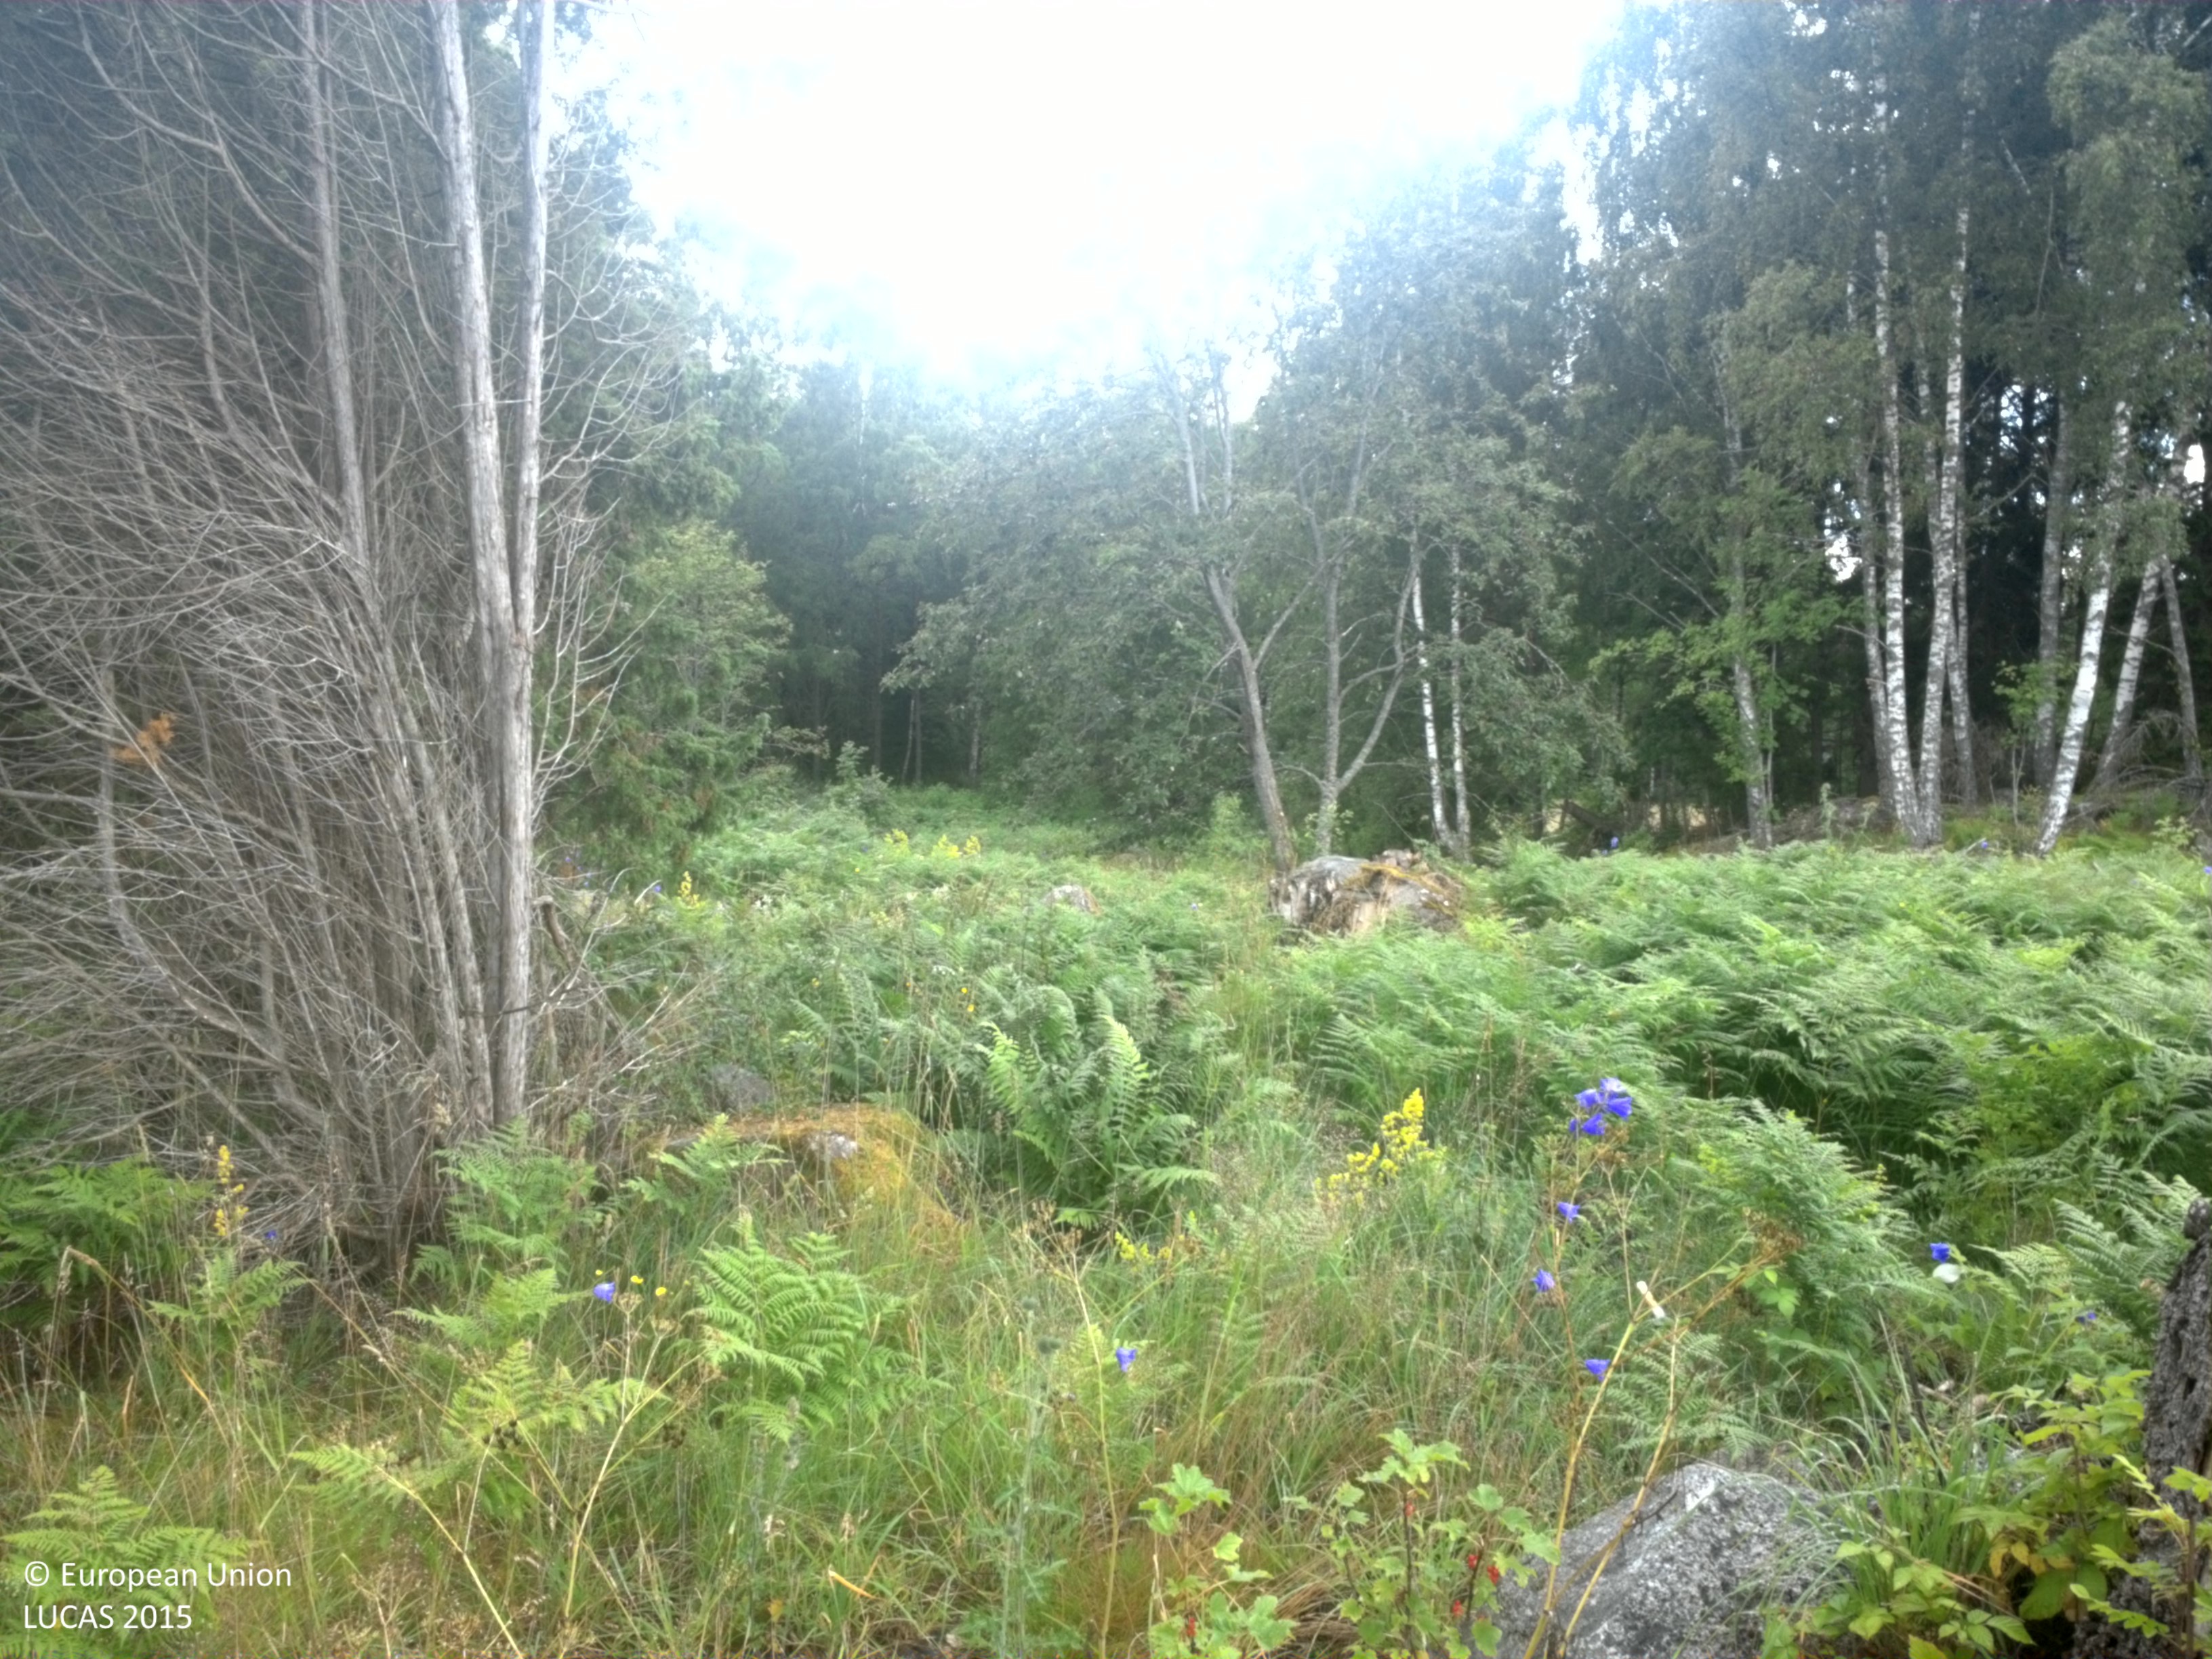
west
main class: Woodland
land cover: Broadleaved woodland
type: hemiboreal forest and nemoral coniferous forest and mixed broadleaved-coniferous forest
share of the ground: 10 - 25 %
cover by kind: herbaceous plants 85 %, broadleaved forest trees 15 %
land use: Forestry
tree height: < 5 m
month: July
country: SE
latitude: 59.9042
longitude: 18.5263
